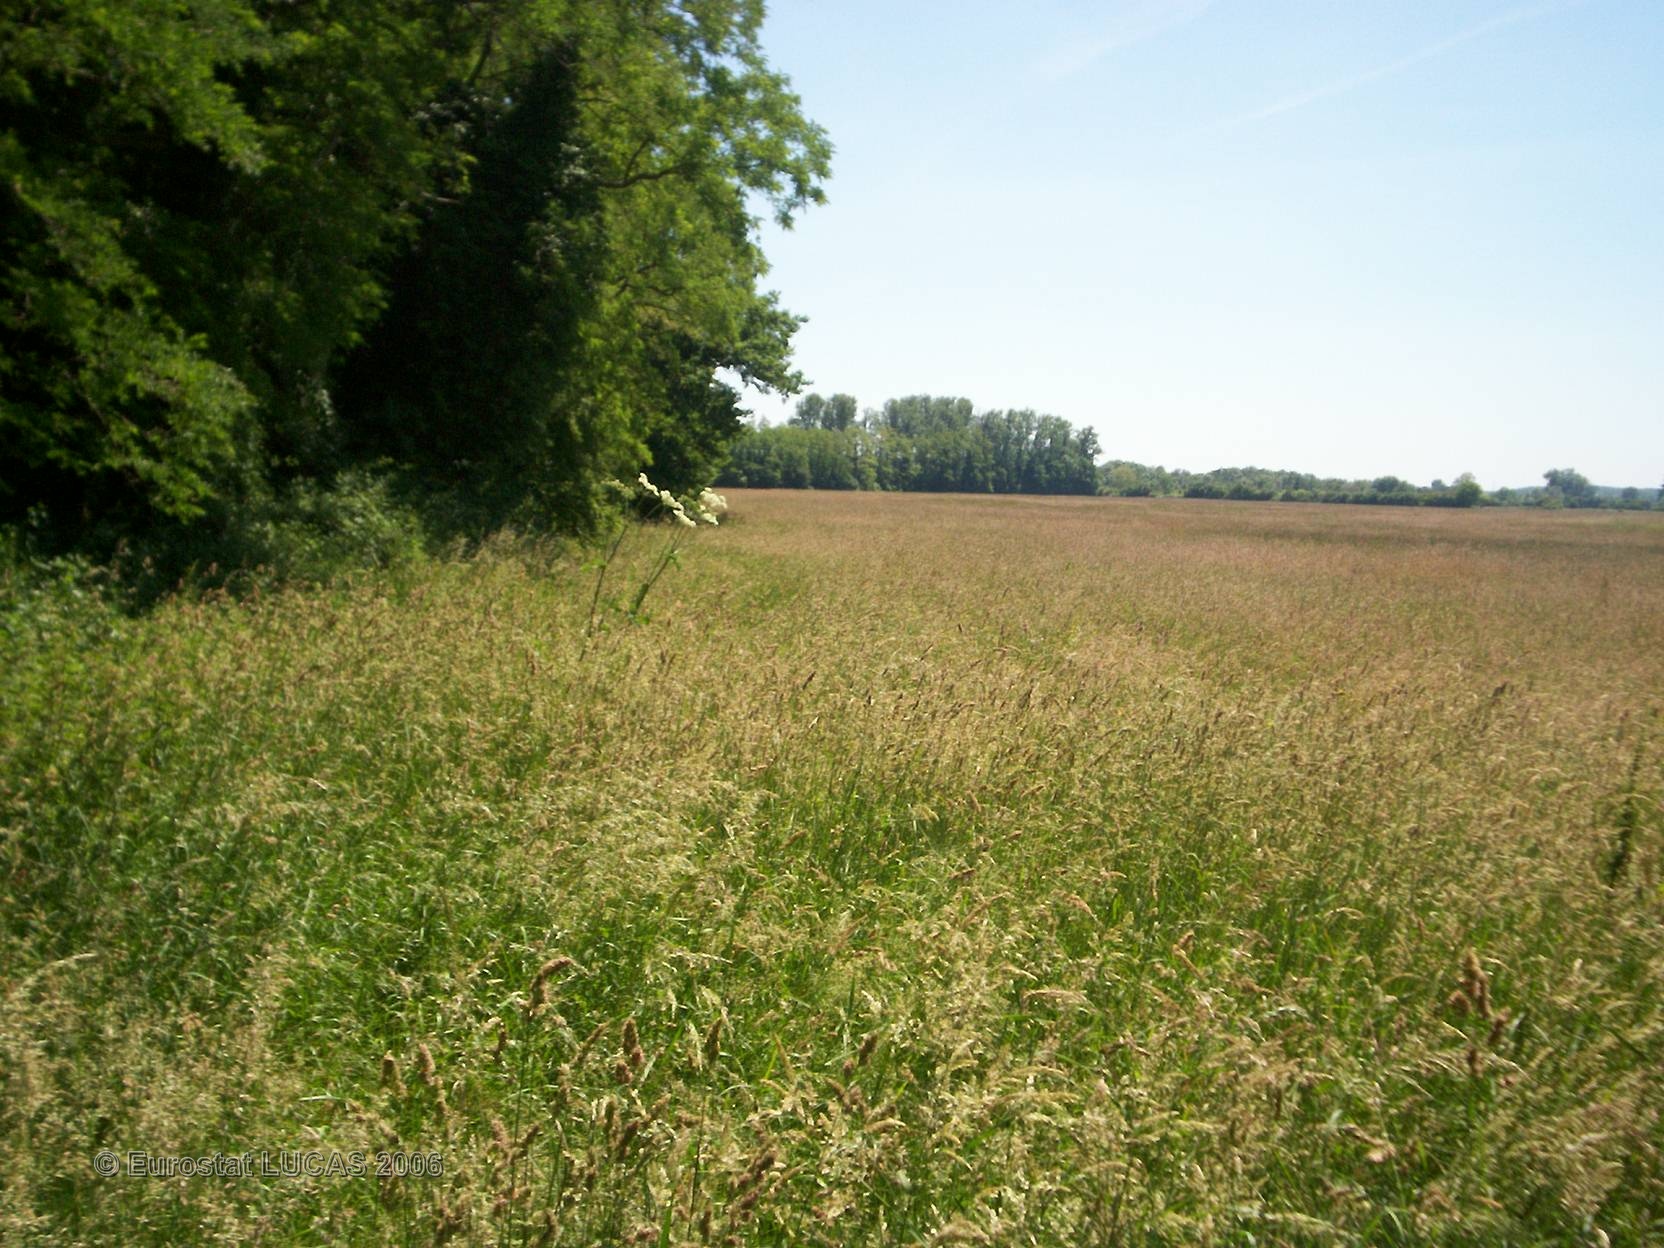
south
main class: Grassland
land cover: Grassland without tree/shrub cover
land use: Agriculture (excluding fallow land and kitchen gardens)
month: June
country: FR
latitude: 47.0115
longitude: 3.0638
